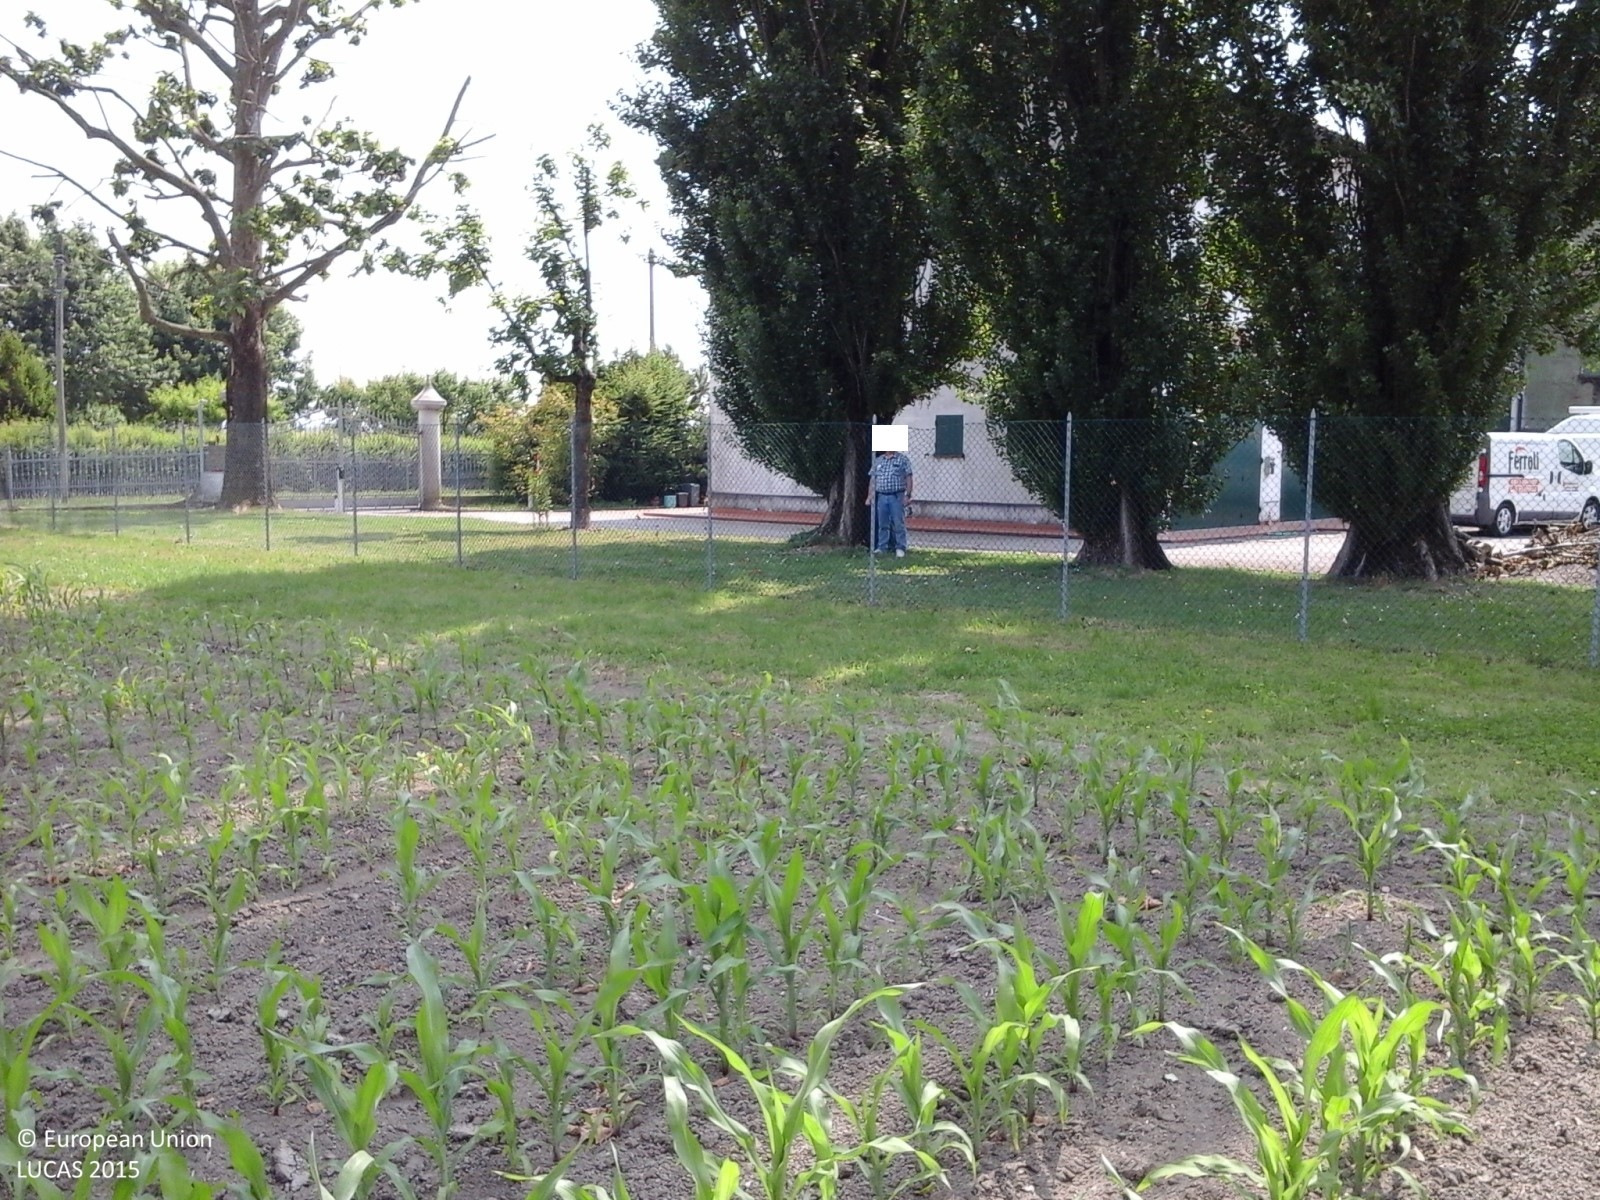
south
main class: Cropland
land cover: Maize
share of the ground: 50 - 75 %
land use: Agriculture (excluding fallow land and kitchen gardens)
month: May
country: IT
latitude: 44.7809
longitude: 10.7189
